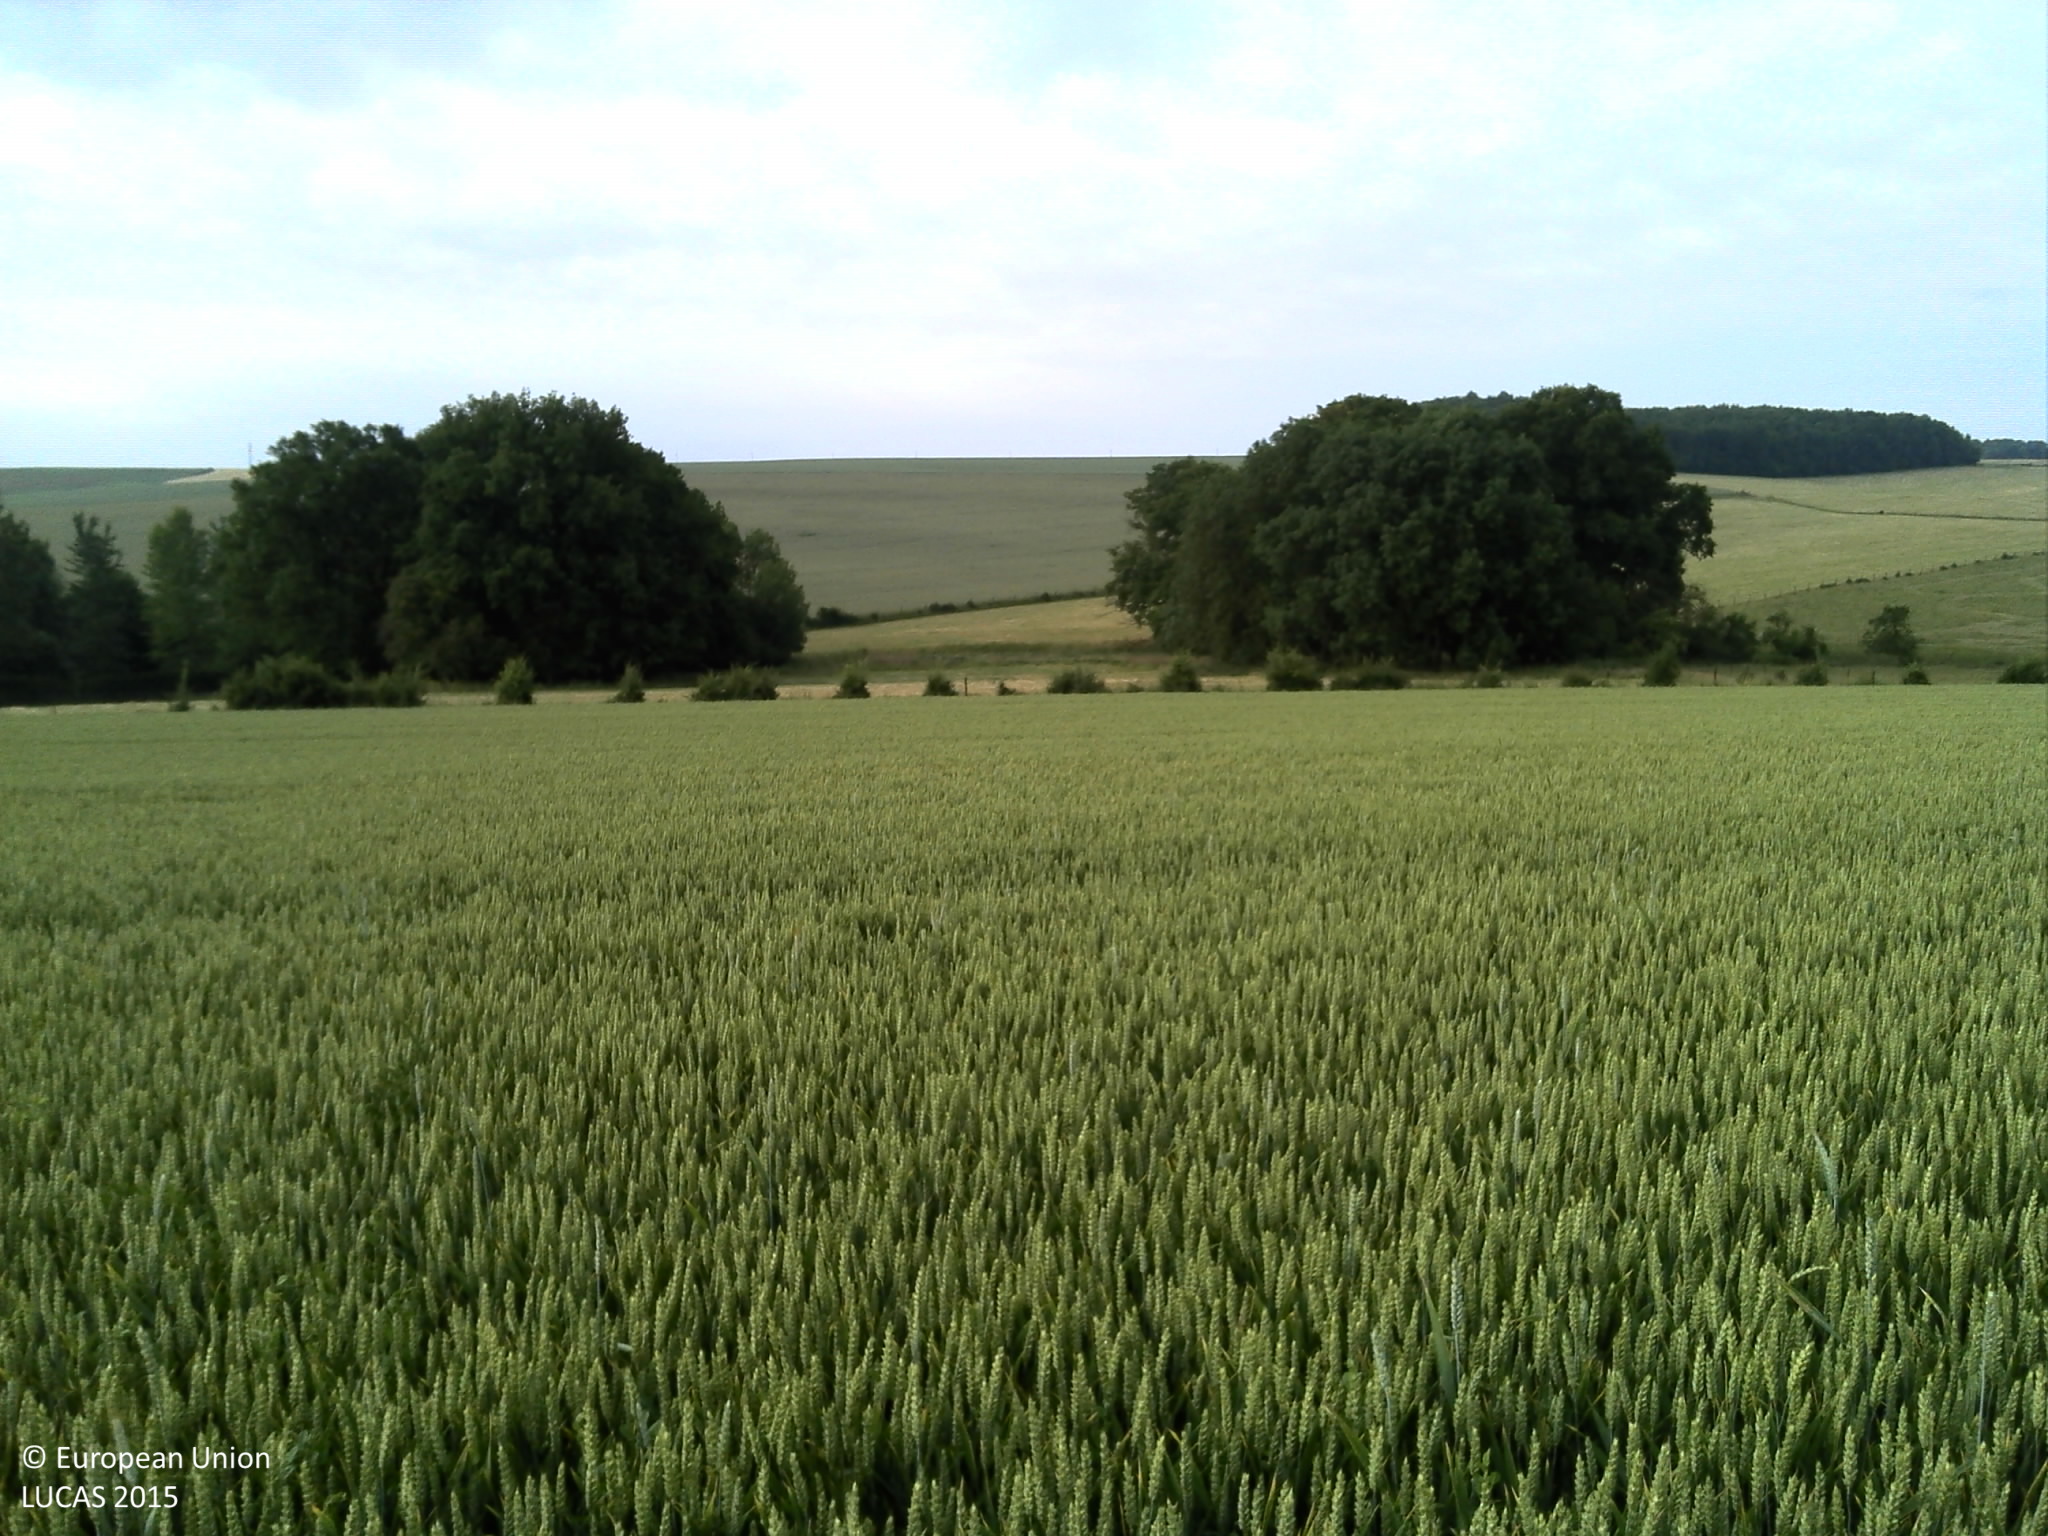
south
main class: Cropland
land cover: Common wheat
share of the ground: > 75 %
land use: Agriculture (excluding fallow land and kitchen gardens)
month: June
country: FR
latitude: 49.3754
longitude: 5.0808
